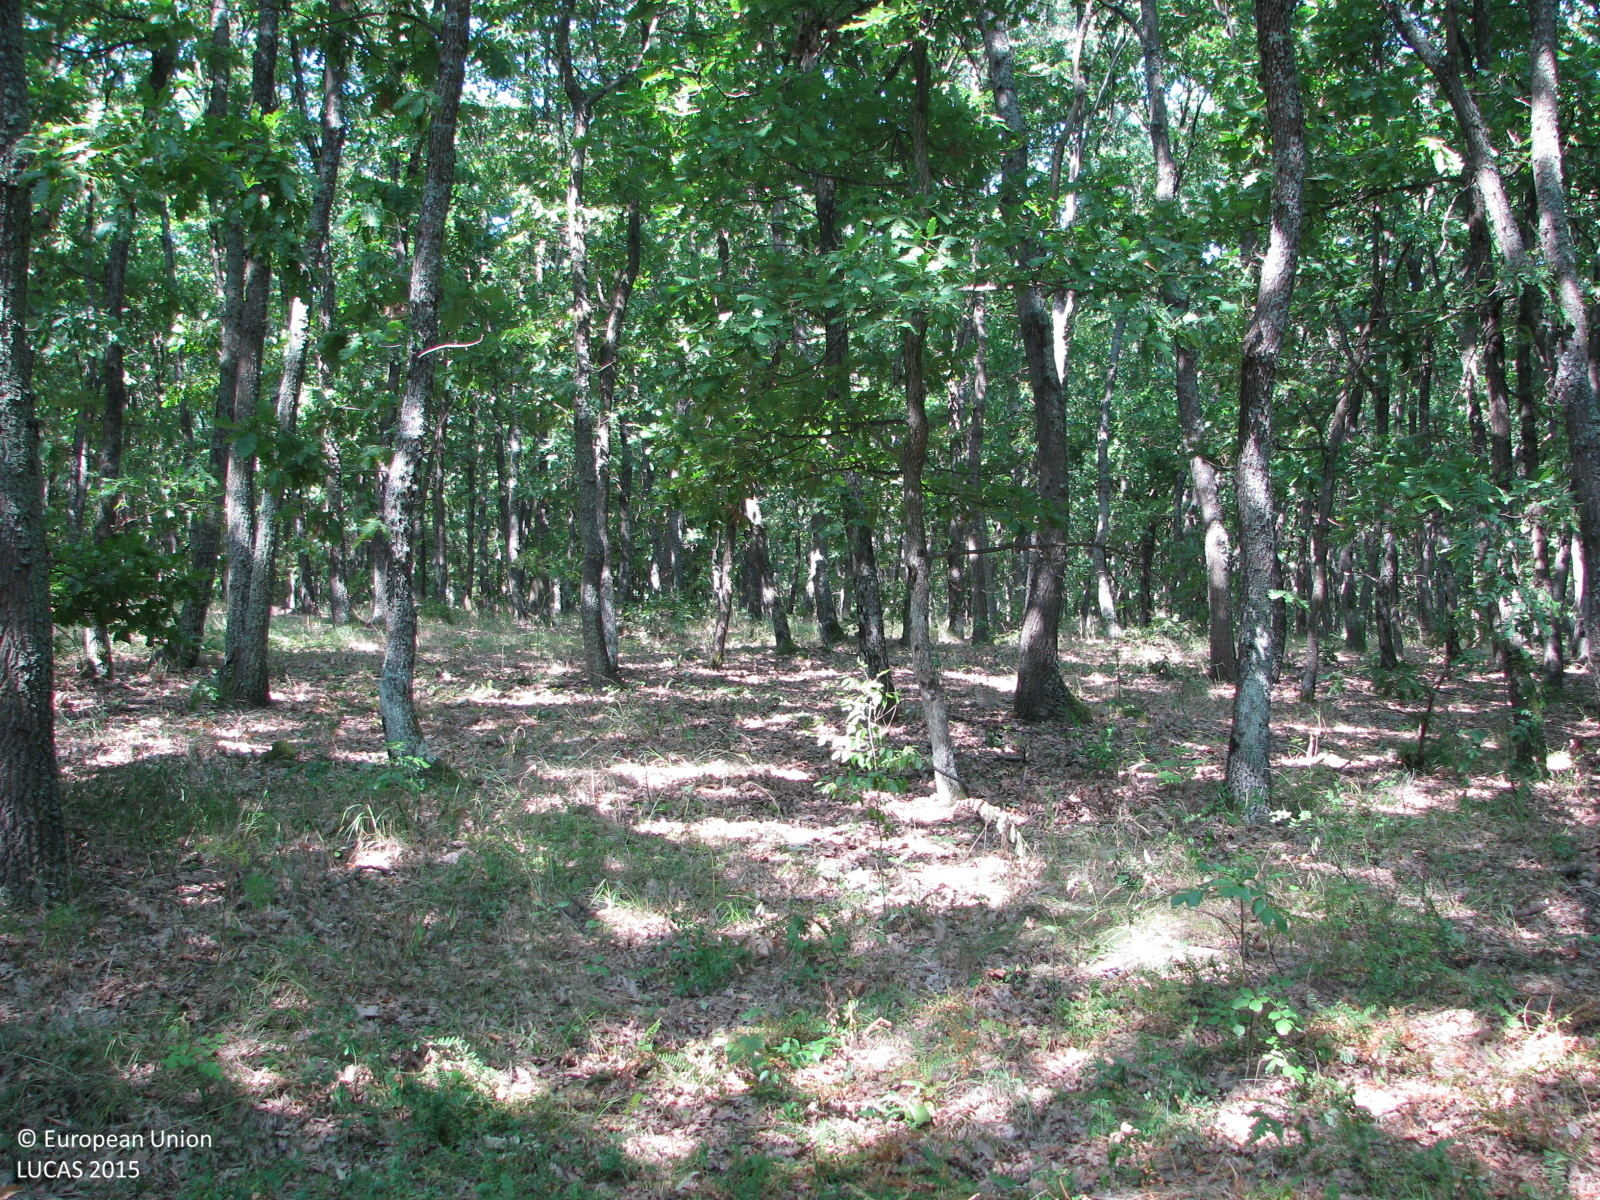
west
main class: Woodland
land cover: Broadleaved woodland
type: acidophilous oak and oak-birch forest
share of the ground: 50 - 75 %
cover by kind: broadleaved forest trees 55 %, consolidated bare surface 30 %, shrubs 5 %, herbaceous plants 5 %, lichens and mosses 5 %
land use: Forestry
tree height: > 5 m
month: August
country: BG
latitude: 42.6933
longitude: 26.6876
